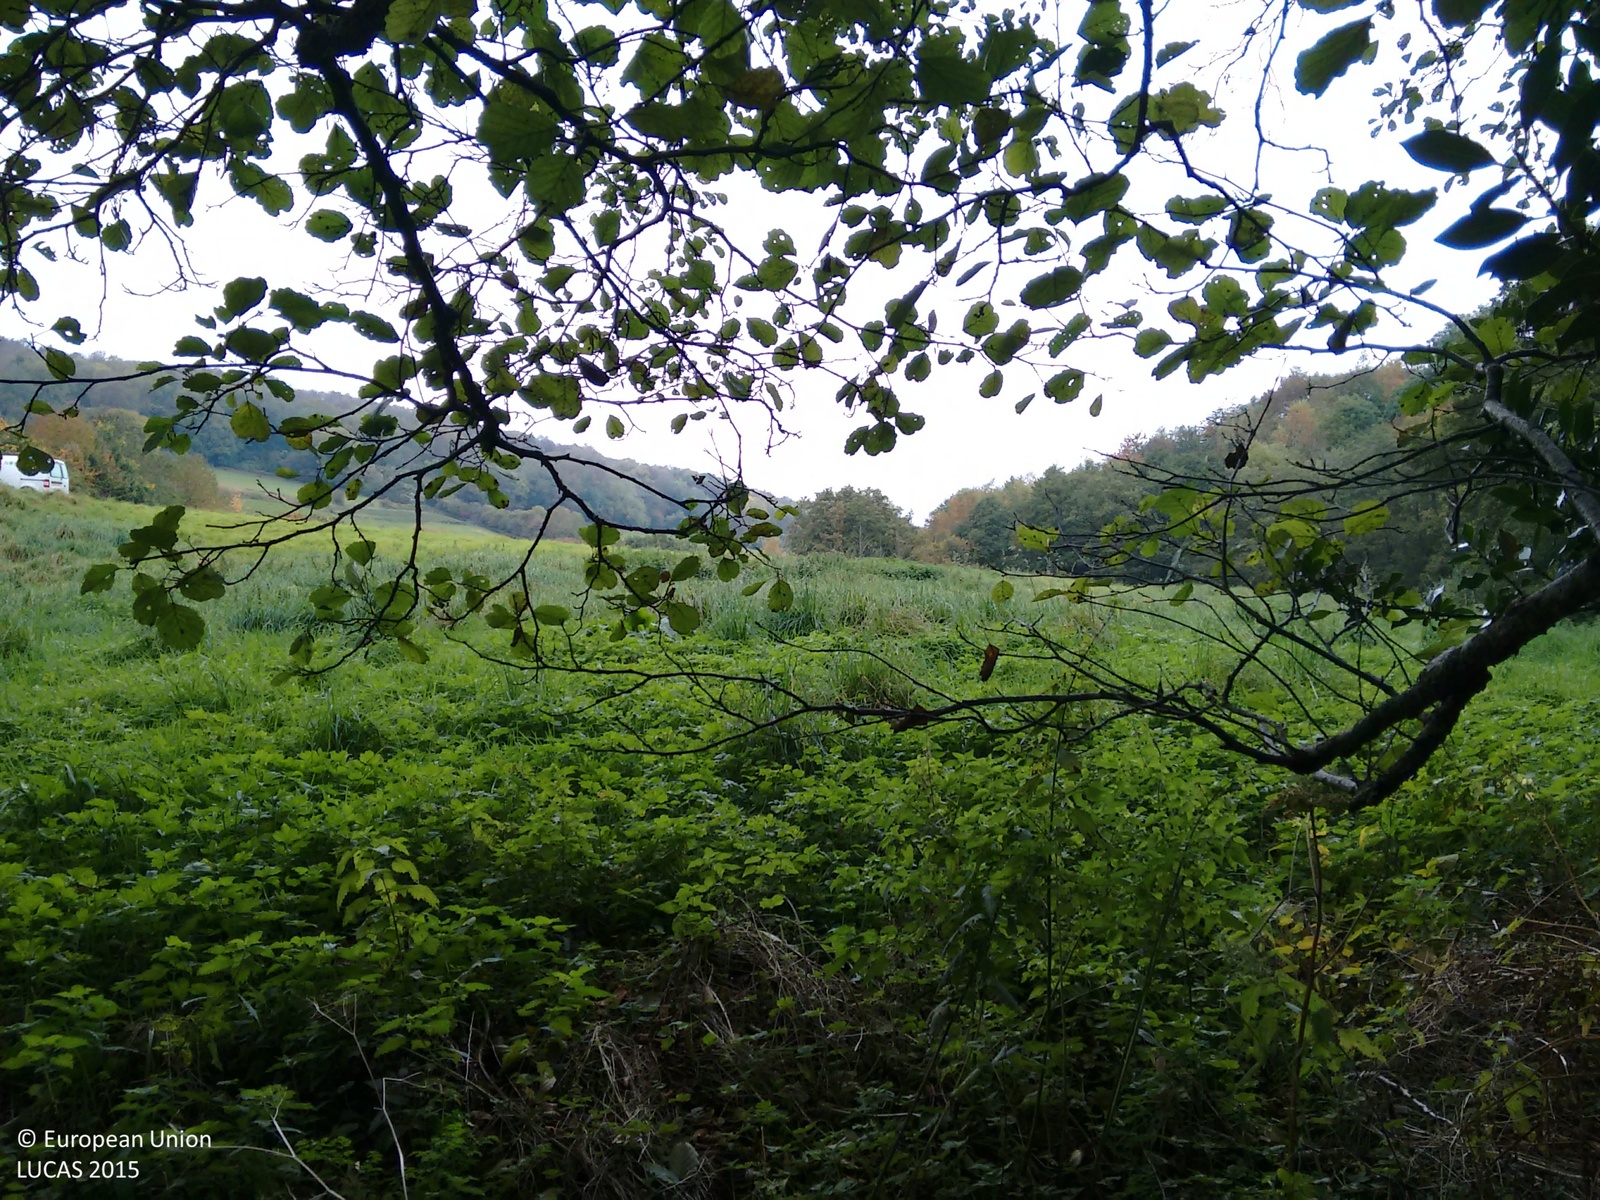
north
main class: Woodland
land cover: Broadleaved woodland
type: mesophytic deciduous forest
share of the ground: > 75 %
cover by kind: broadleaved forest trees 80 %, shrubs 10 %, herbaceous plants 10 %
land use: Semi-natural and natural areas not in use
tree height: > 5 m
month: October
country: GB
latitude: 51.7688
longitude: -2.6620
